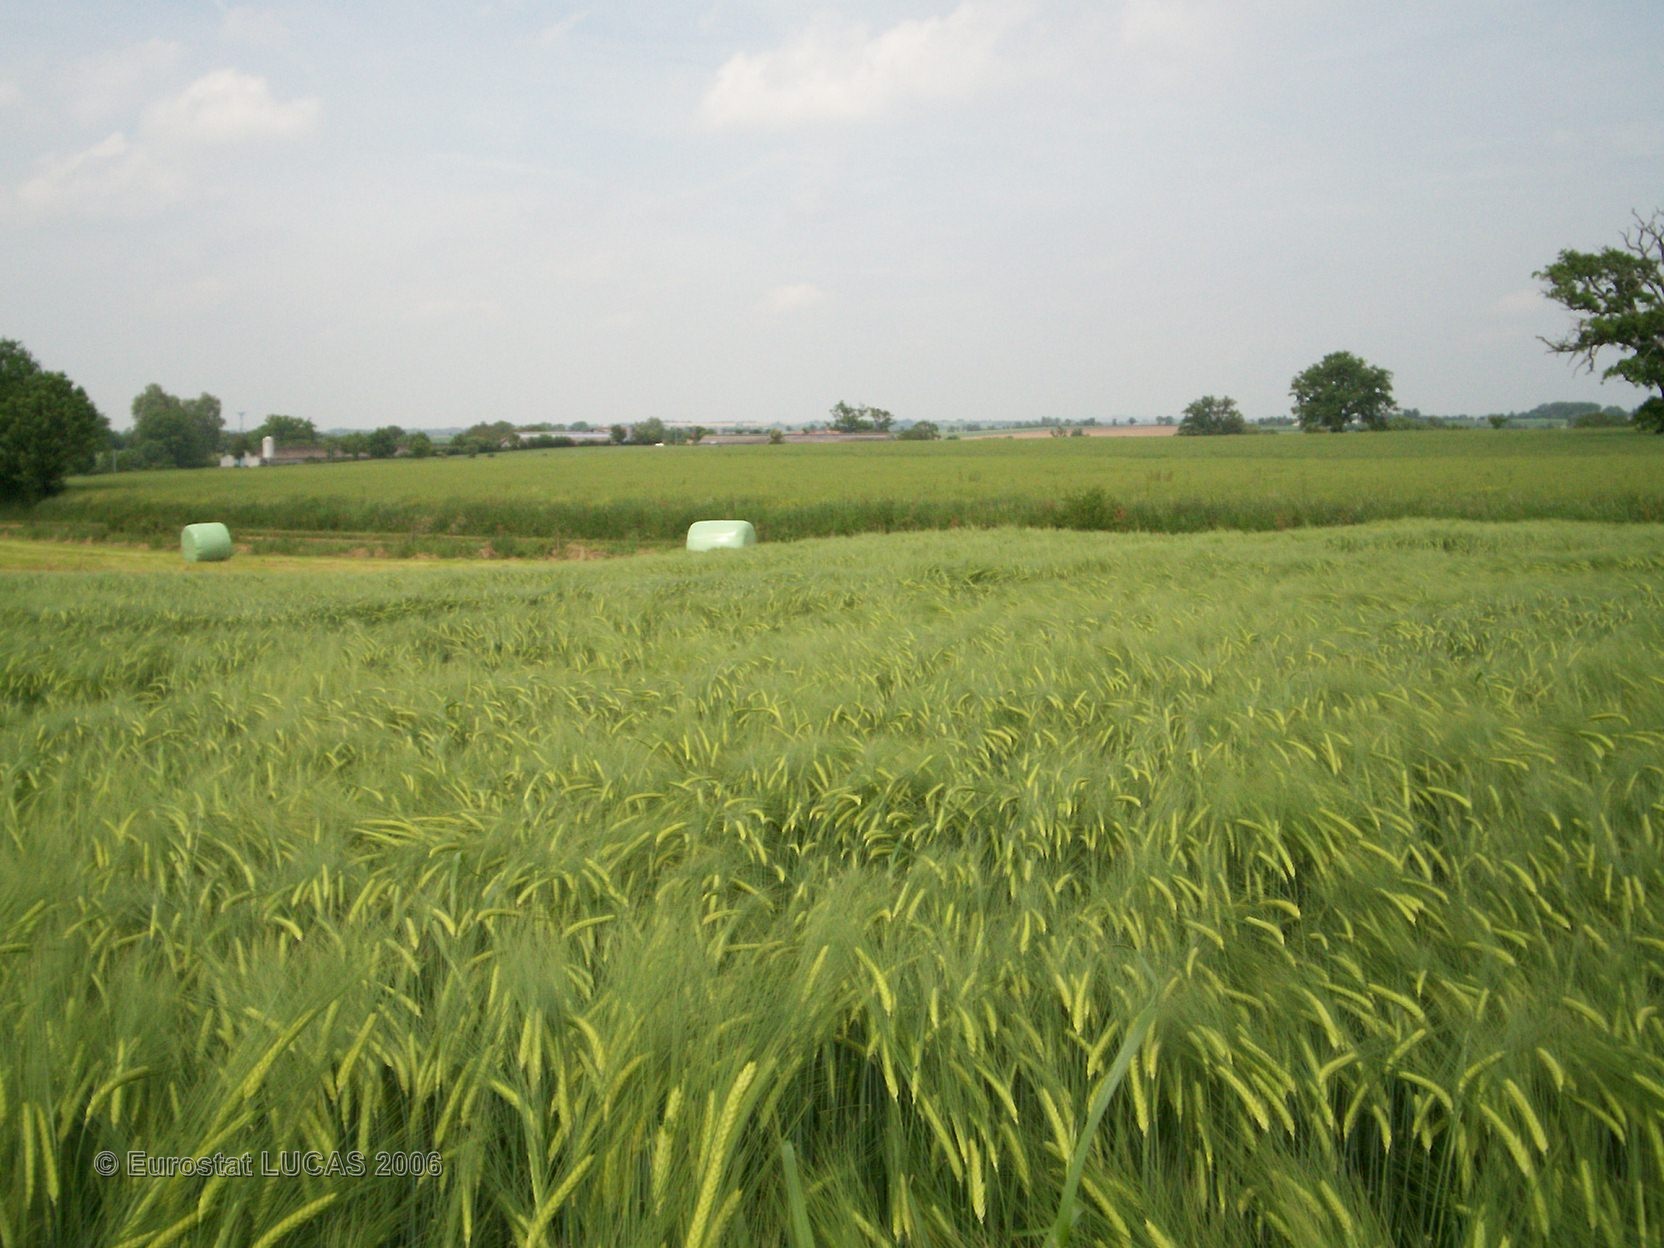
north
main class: Cropland
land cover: Barley
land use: Agriculture (excluding fallow land and kitchen gardens)
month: May
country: FR
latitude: 46.6322
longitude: -0.8593
